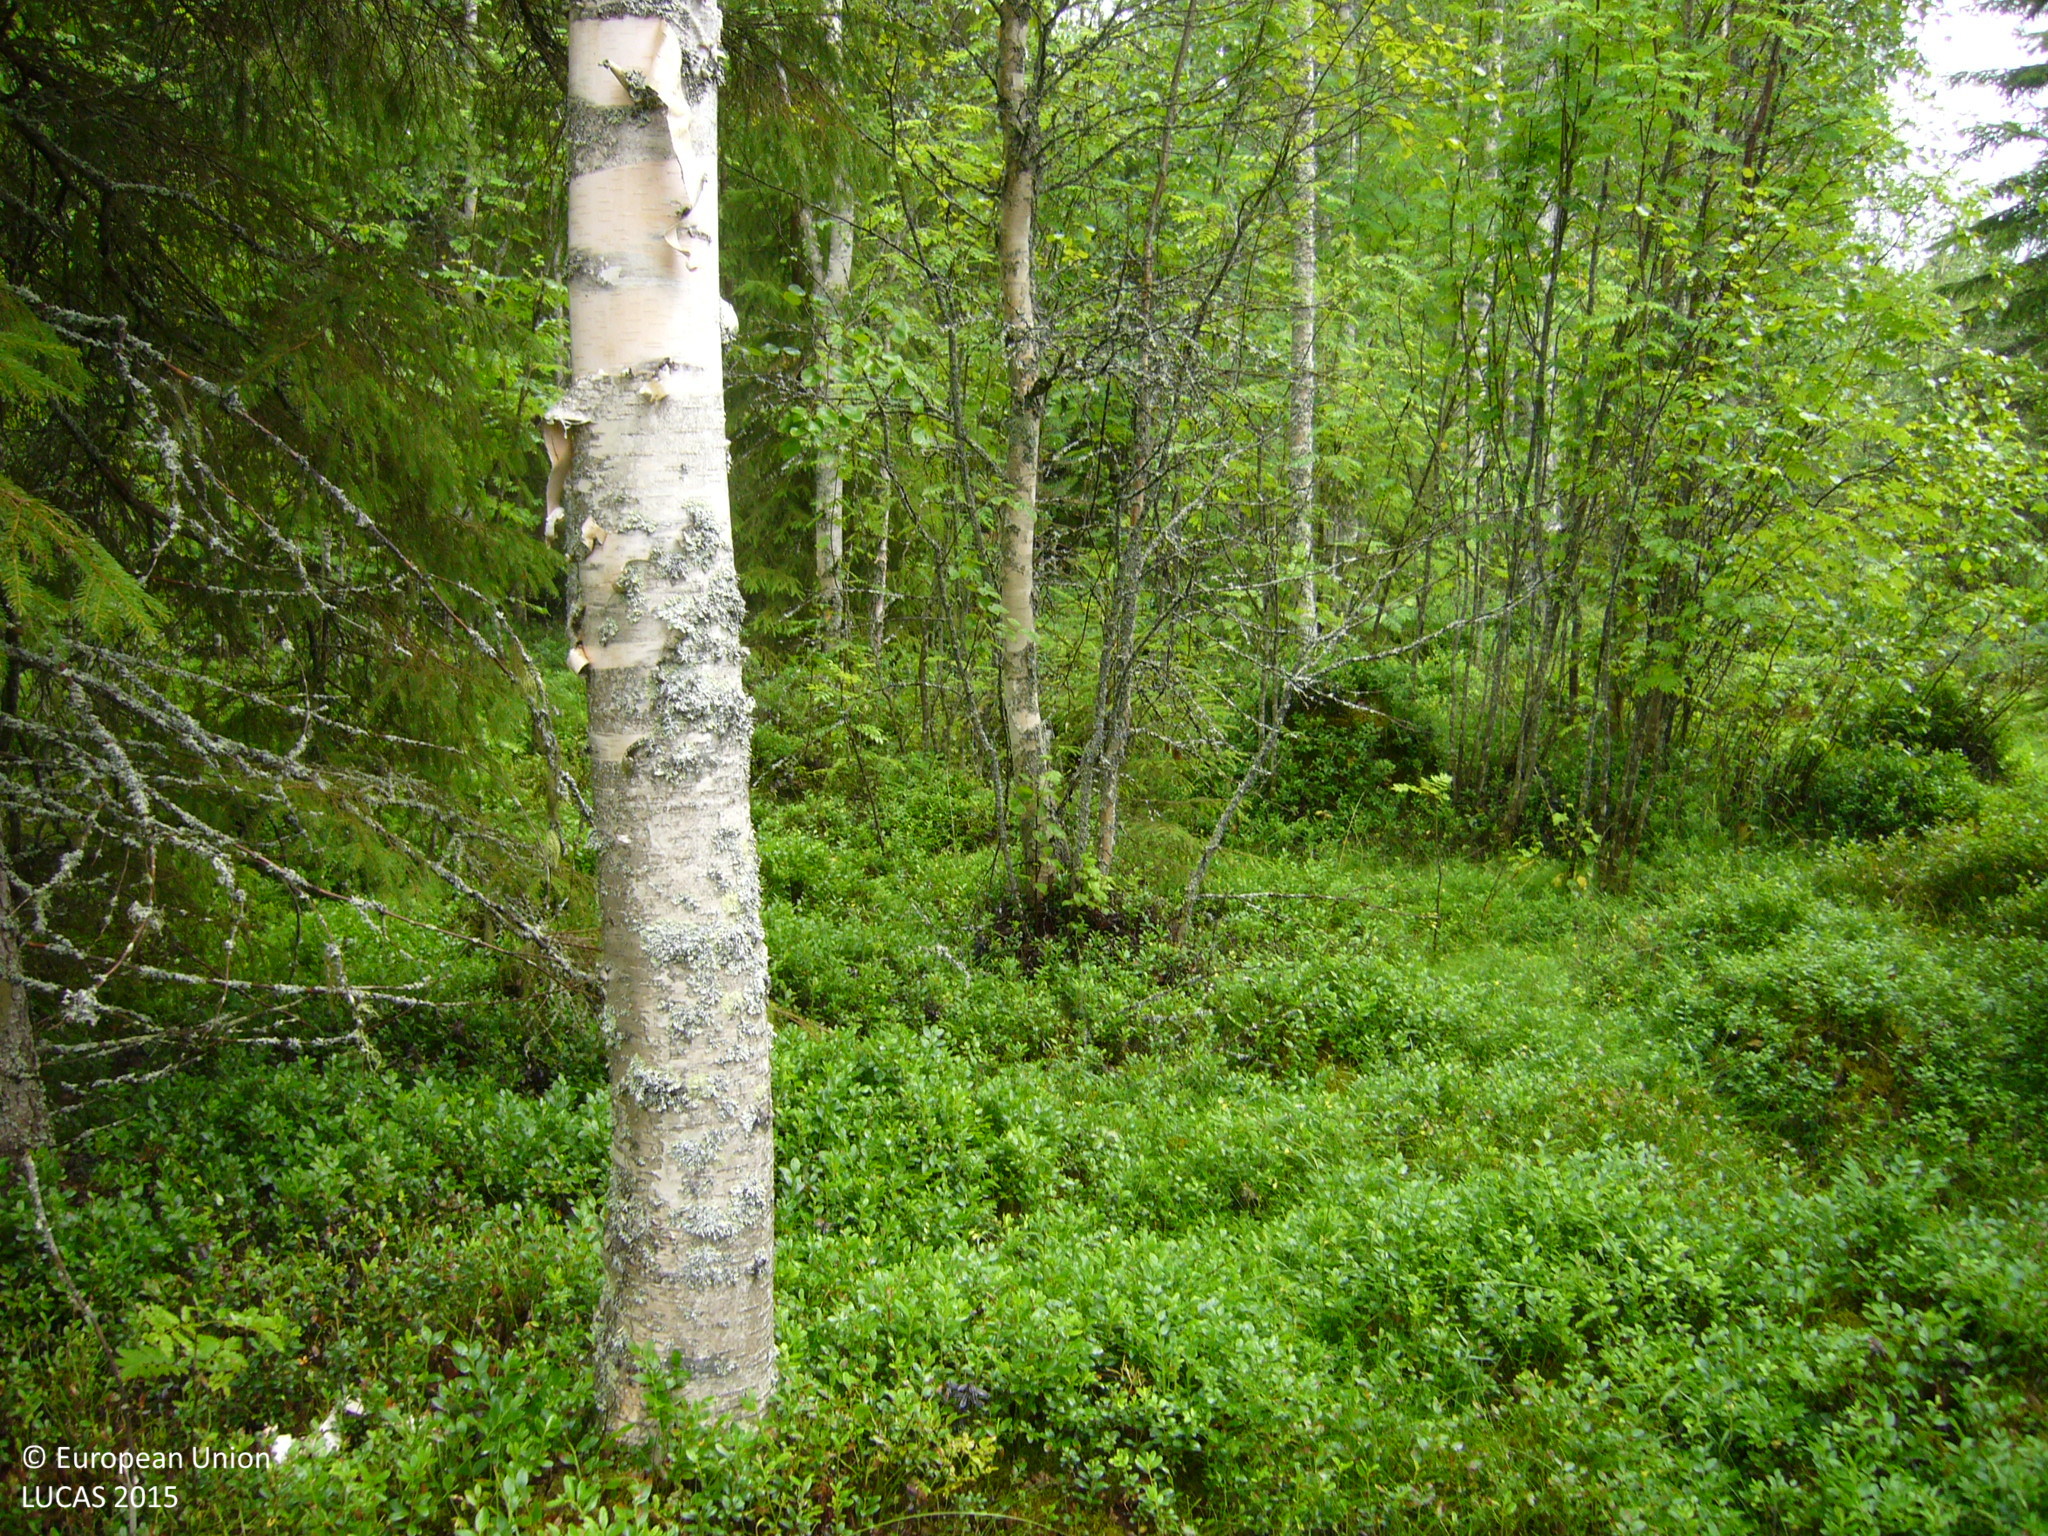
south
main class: Woodland
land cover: Other mixed woodland
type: boreal forest
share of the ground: > 75 %
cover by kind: broadleaved forest trees 45 %, coniferous forest trees 35 %, shrubs 20 %
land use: Forestry
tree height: > 5 m
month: July
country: FI
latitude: 63.8214
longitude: 25.9763
